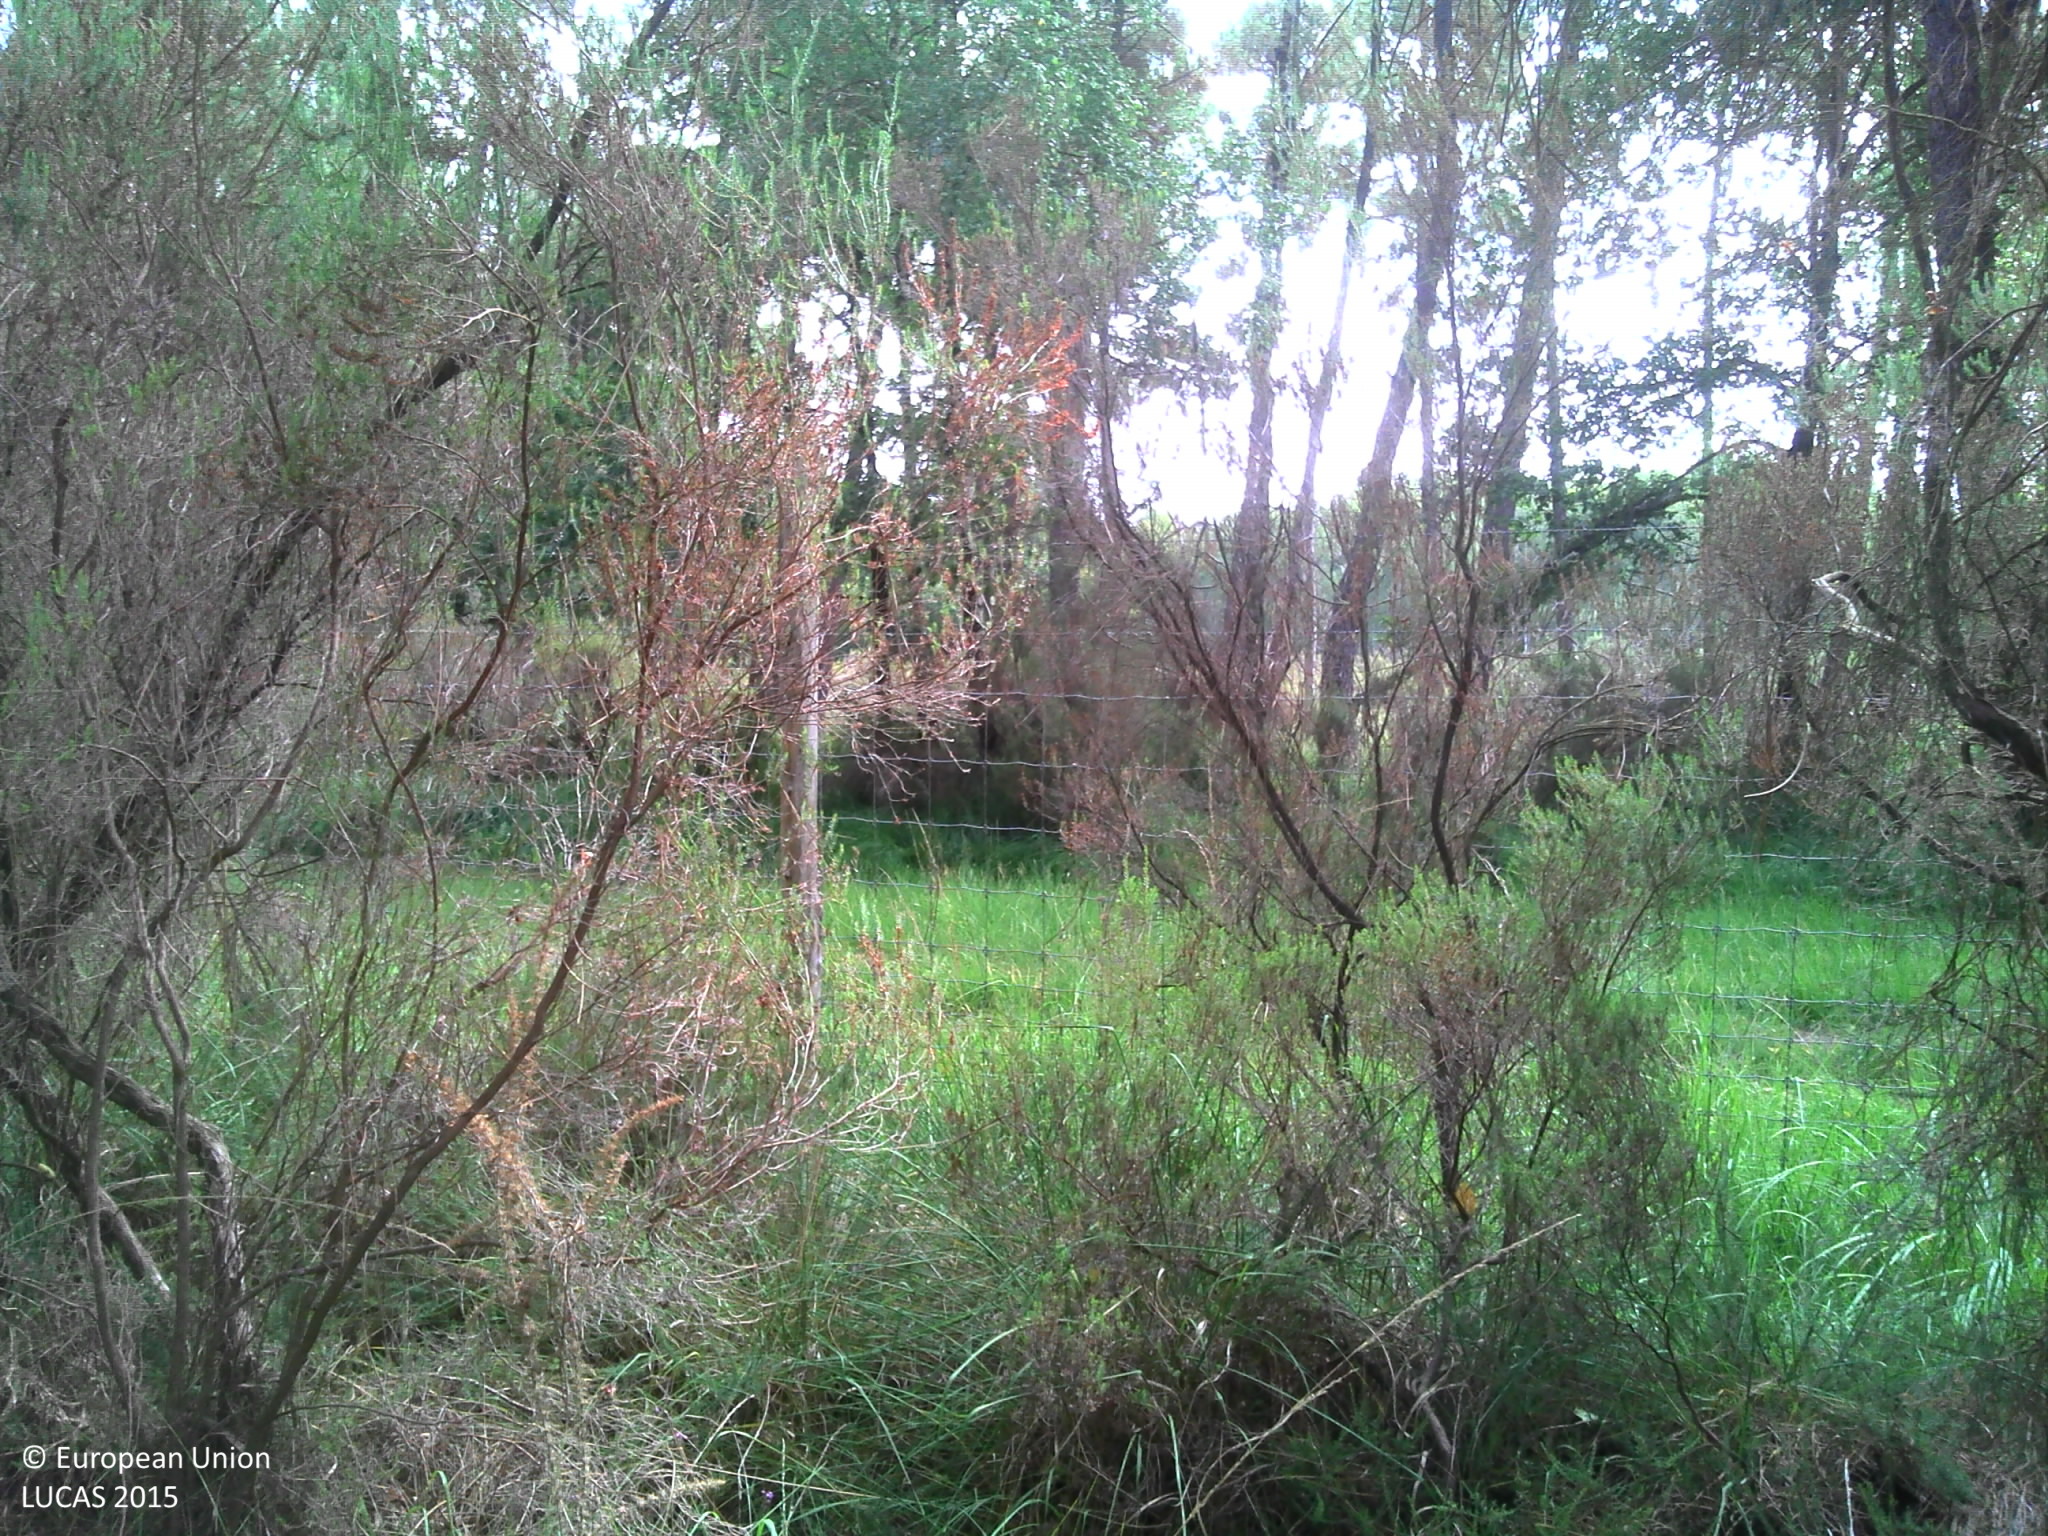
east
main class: Woodland
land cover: Pine dominated coniferous woodland
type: exotic forest
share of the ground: > 75 %
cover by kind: coniferous forest trees 55 %, herbaceous plants 20 %, broadleaved forest trees 10 %, shrubs 10 %, lichens and mosses 5 %
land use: Forestry
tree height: > 5 m
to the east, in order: Pine dominated coniferous woodland; Fences; Grassland without tree/shrub cover; Pine dominated coniferous woodland; Shrubland without tree cover; Broadleaved woodland; Tracks; Pine dominated coniferous woodland
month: August
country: FR
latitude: 47.1815
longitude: 0.3322
